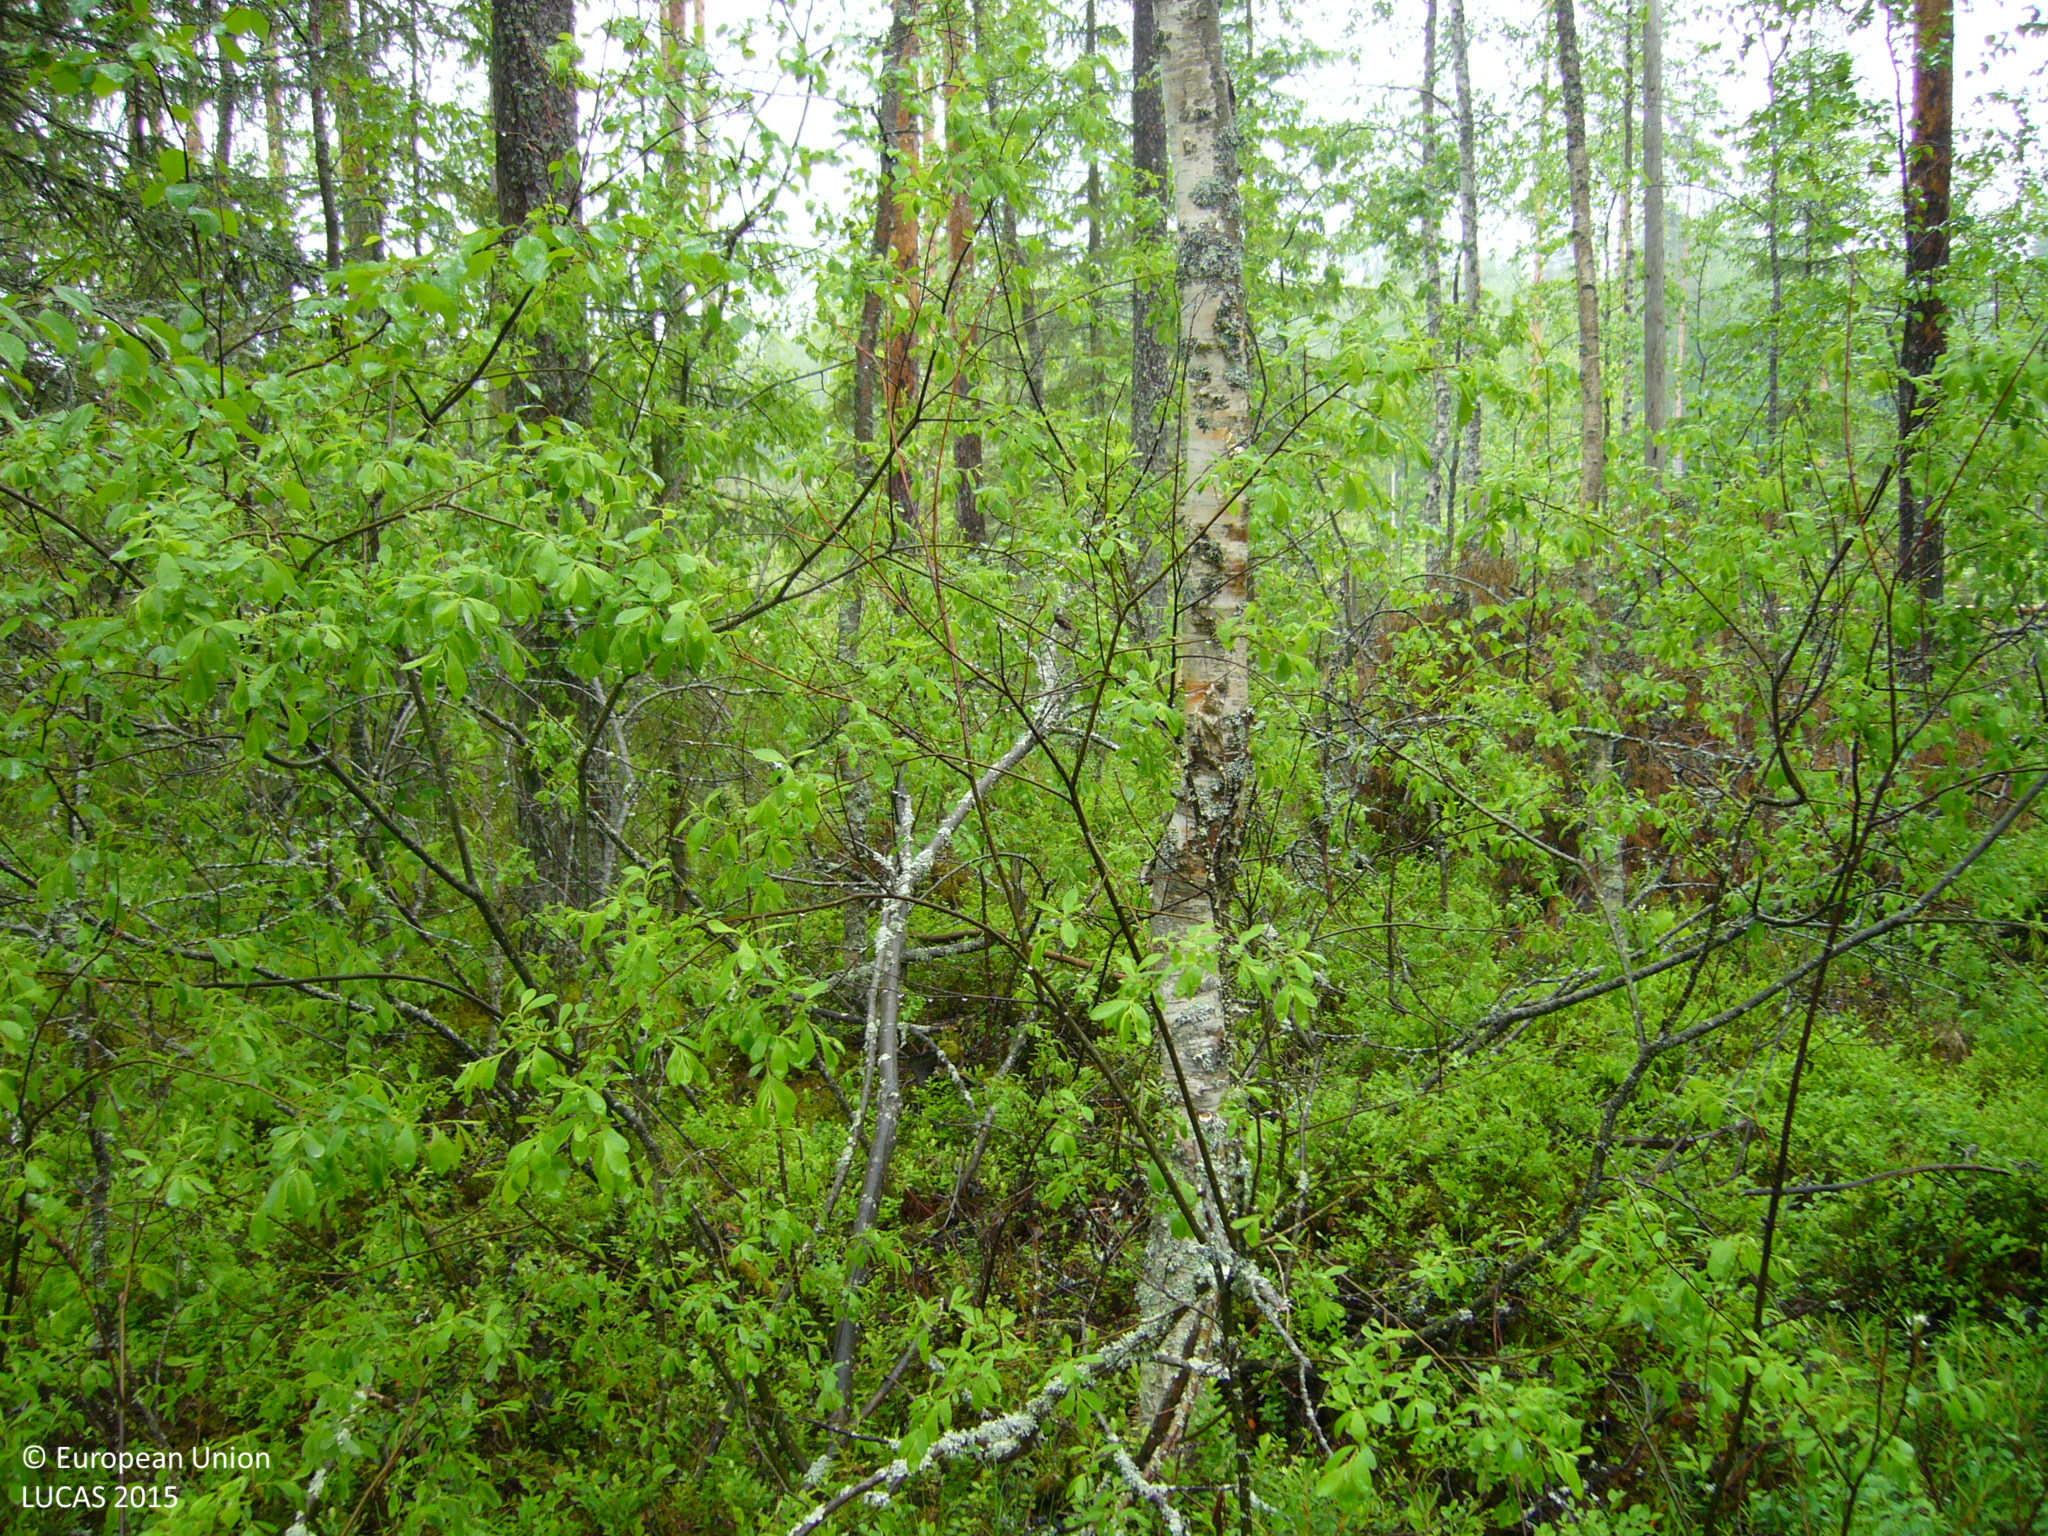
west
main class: Woodland
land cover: Pine dominated mixed woodland
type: boreal forest
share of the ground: 50 - 75 %
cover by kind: coniferous forest trees 40 %, shrubs 35 %, broadleaved forest trees 25 %
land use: Forestry
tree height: > 5 m
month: June
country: FI
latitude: 63.8036
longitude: 25.0517
